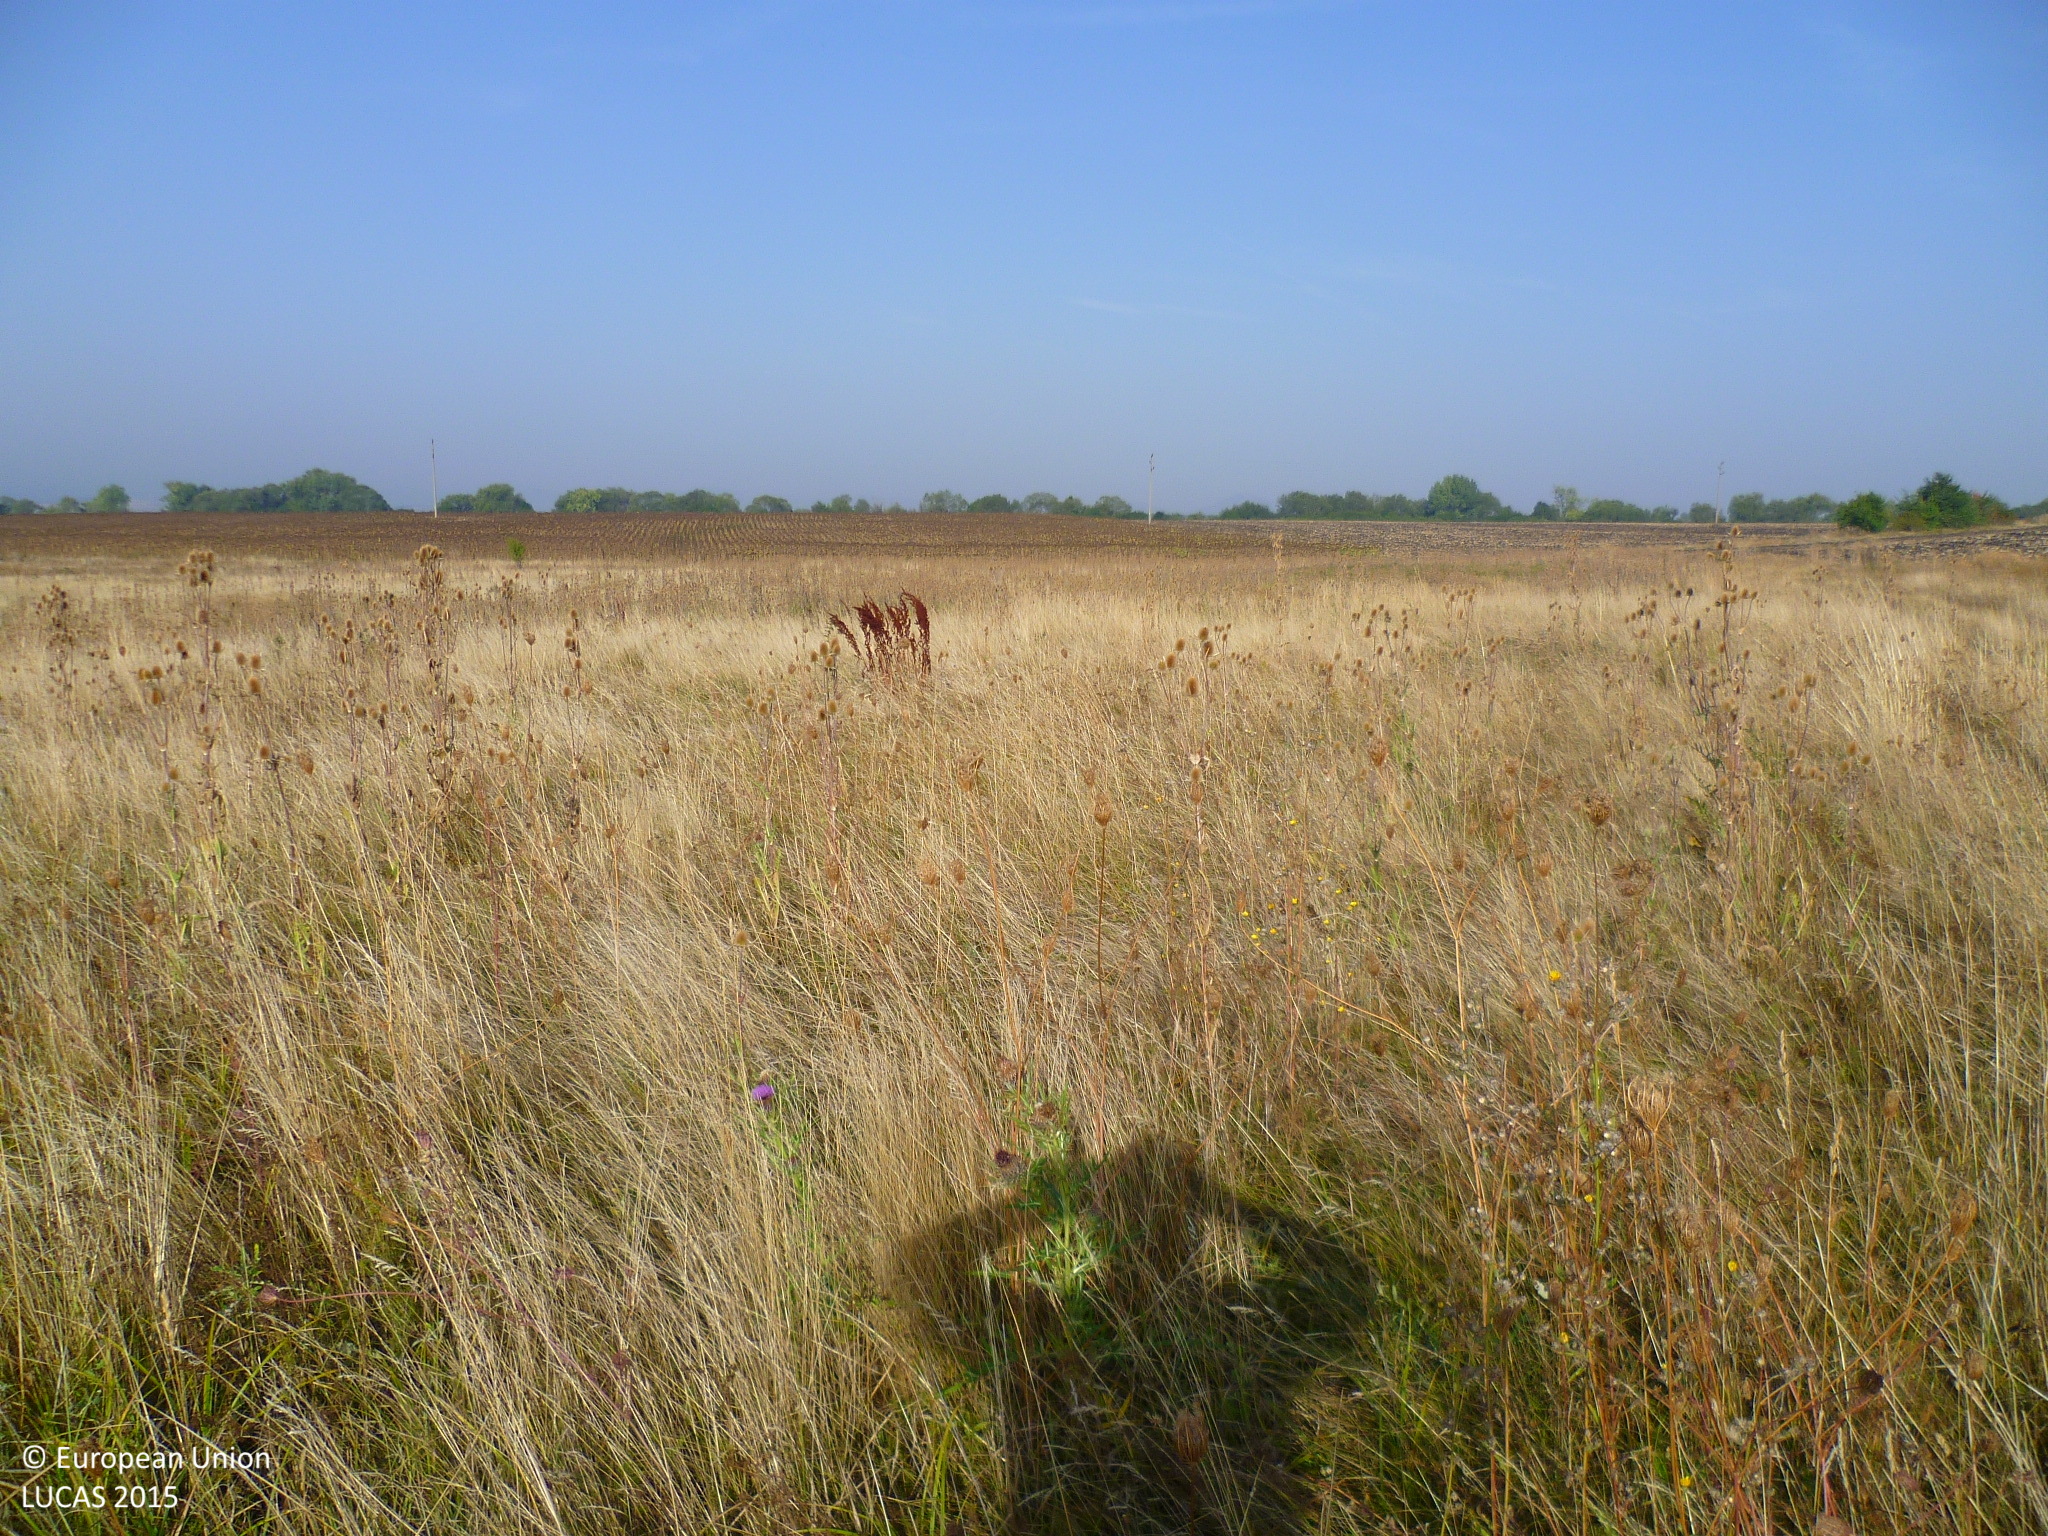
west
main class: Grassland
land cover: Grassland without tree/shrub cover
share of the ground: > 75 %
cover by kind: herbaceous plants 100 %
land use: Agriculture (excluding fallow land and kitchen gardens)
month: September
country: BG
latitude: 42.6885
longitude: 23.0039
